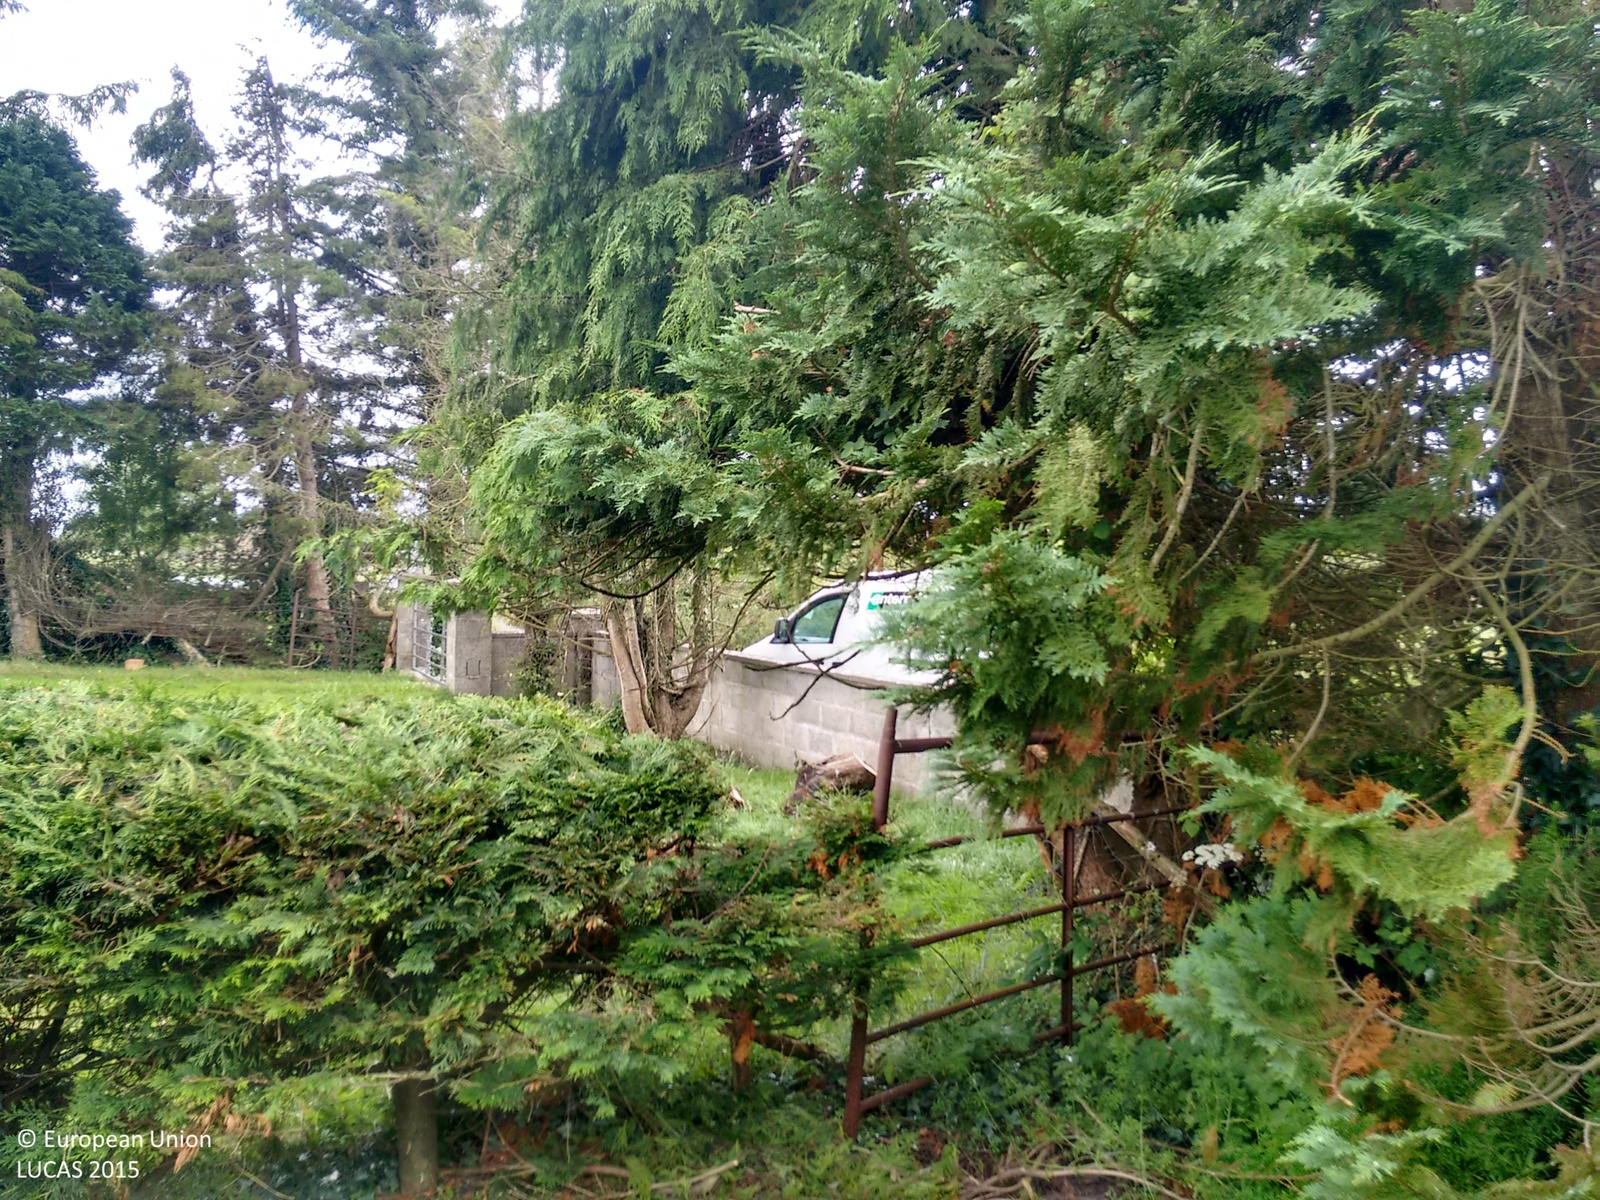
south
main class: Grassland
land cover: Grassland without tree/shrub cover
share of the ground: > 75 %
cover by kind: herbaceous plants 100 %
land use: Agriculture (excluding fallow land and kitchen gardens)
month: July
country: IE
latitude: 53.6567
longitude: -8.8638
